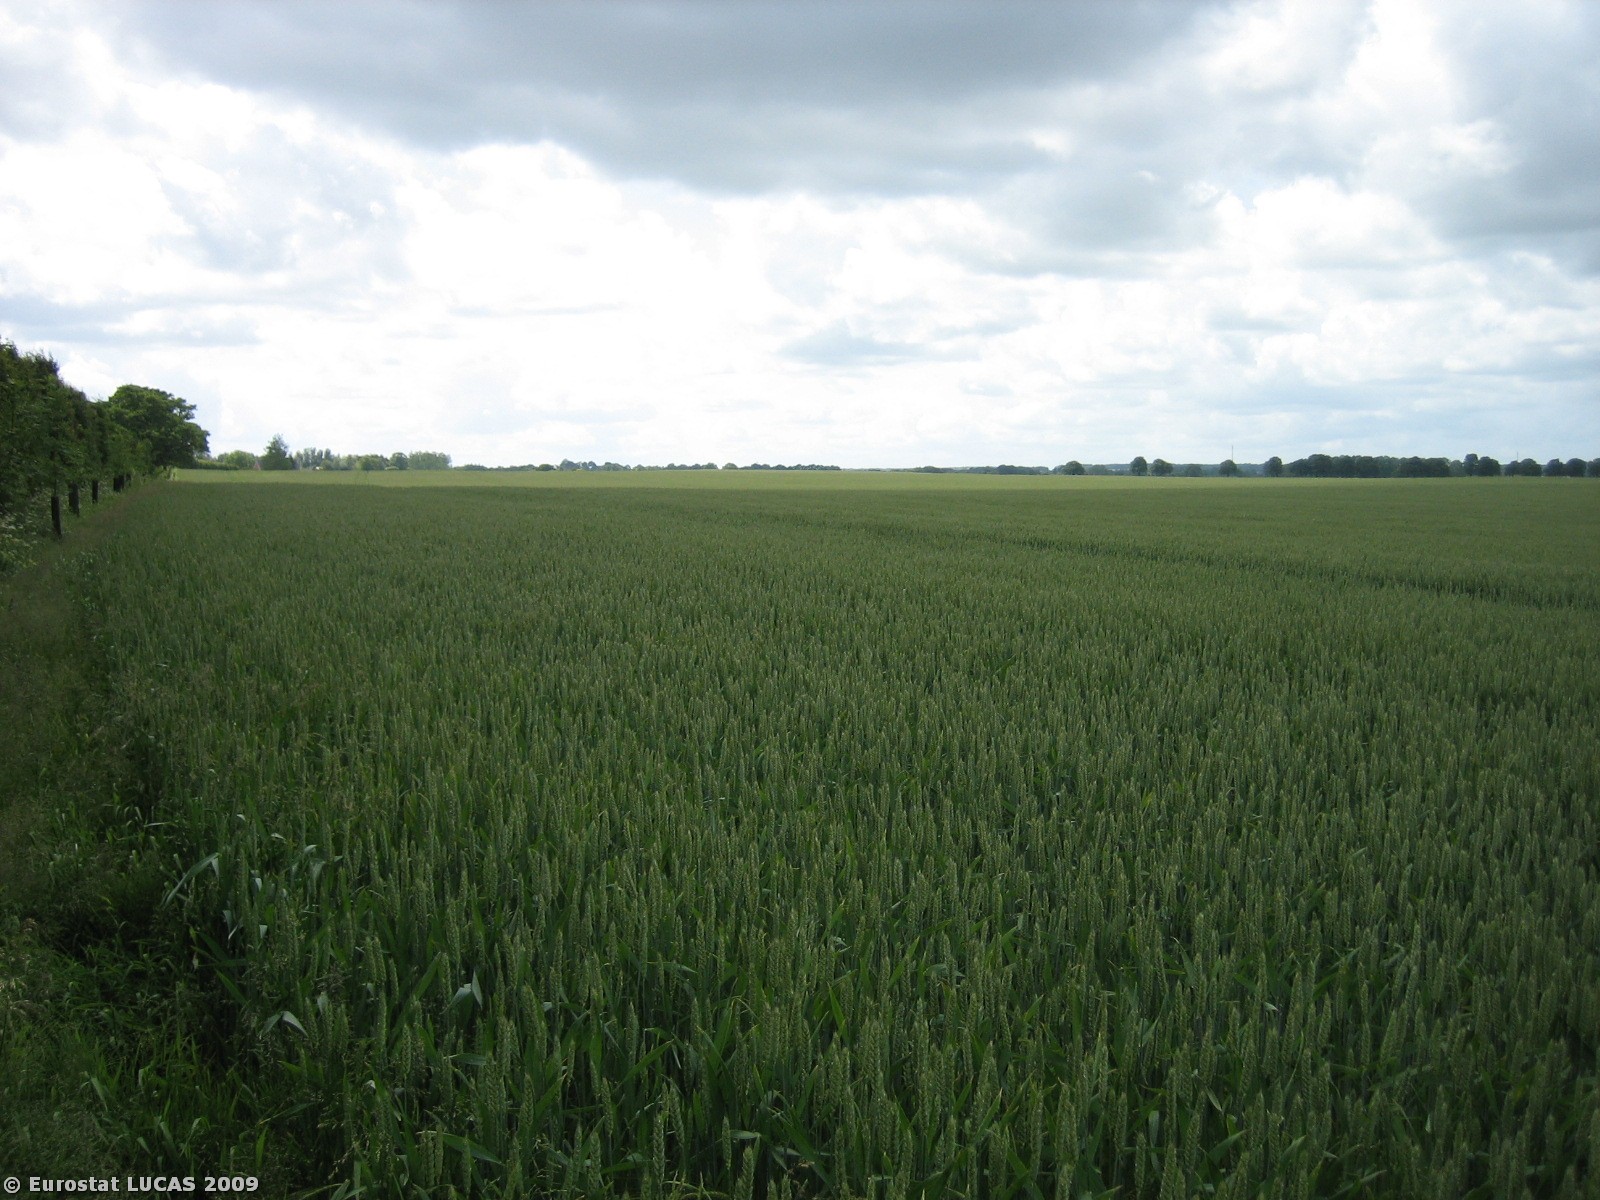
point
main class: Cropland
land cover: Common wheat
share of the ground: > 75 %
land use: Agriculture (excluding fallow land and kitchen gardens)
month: June
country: DK
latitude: 55.5942
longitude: 9.6988
